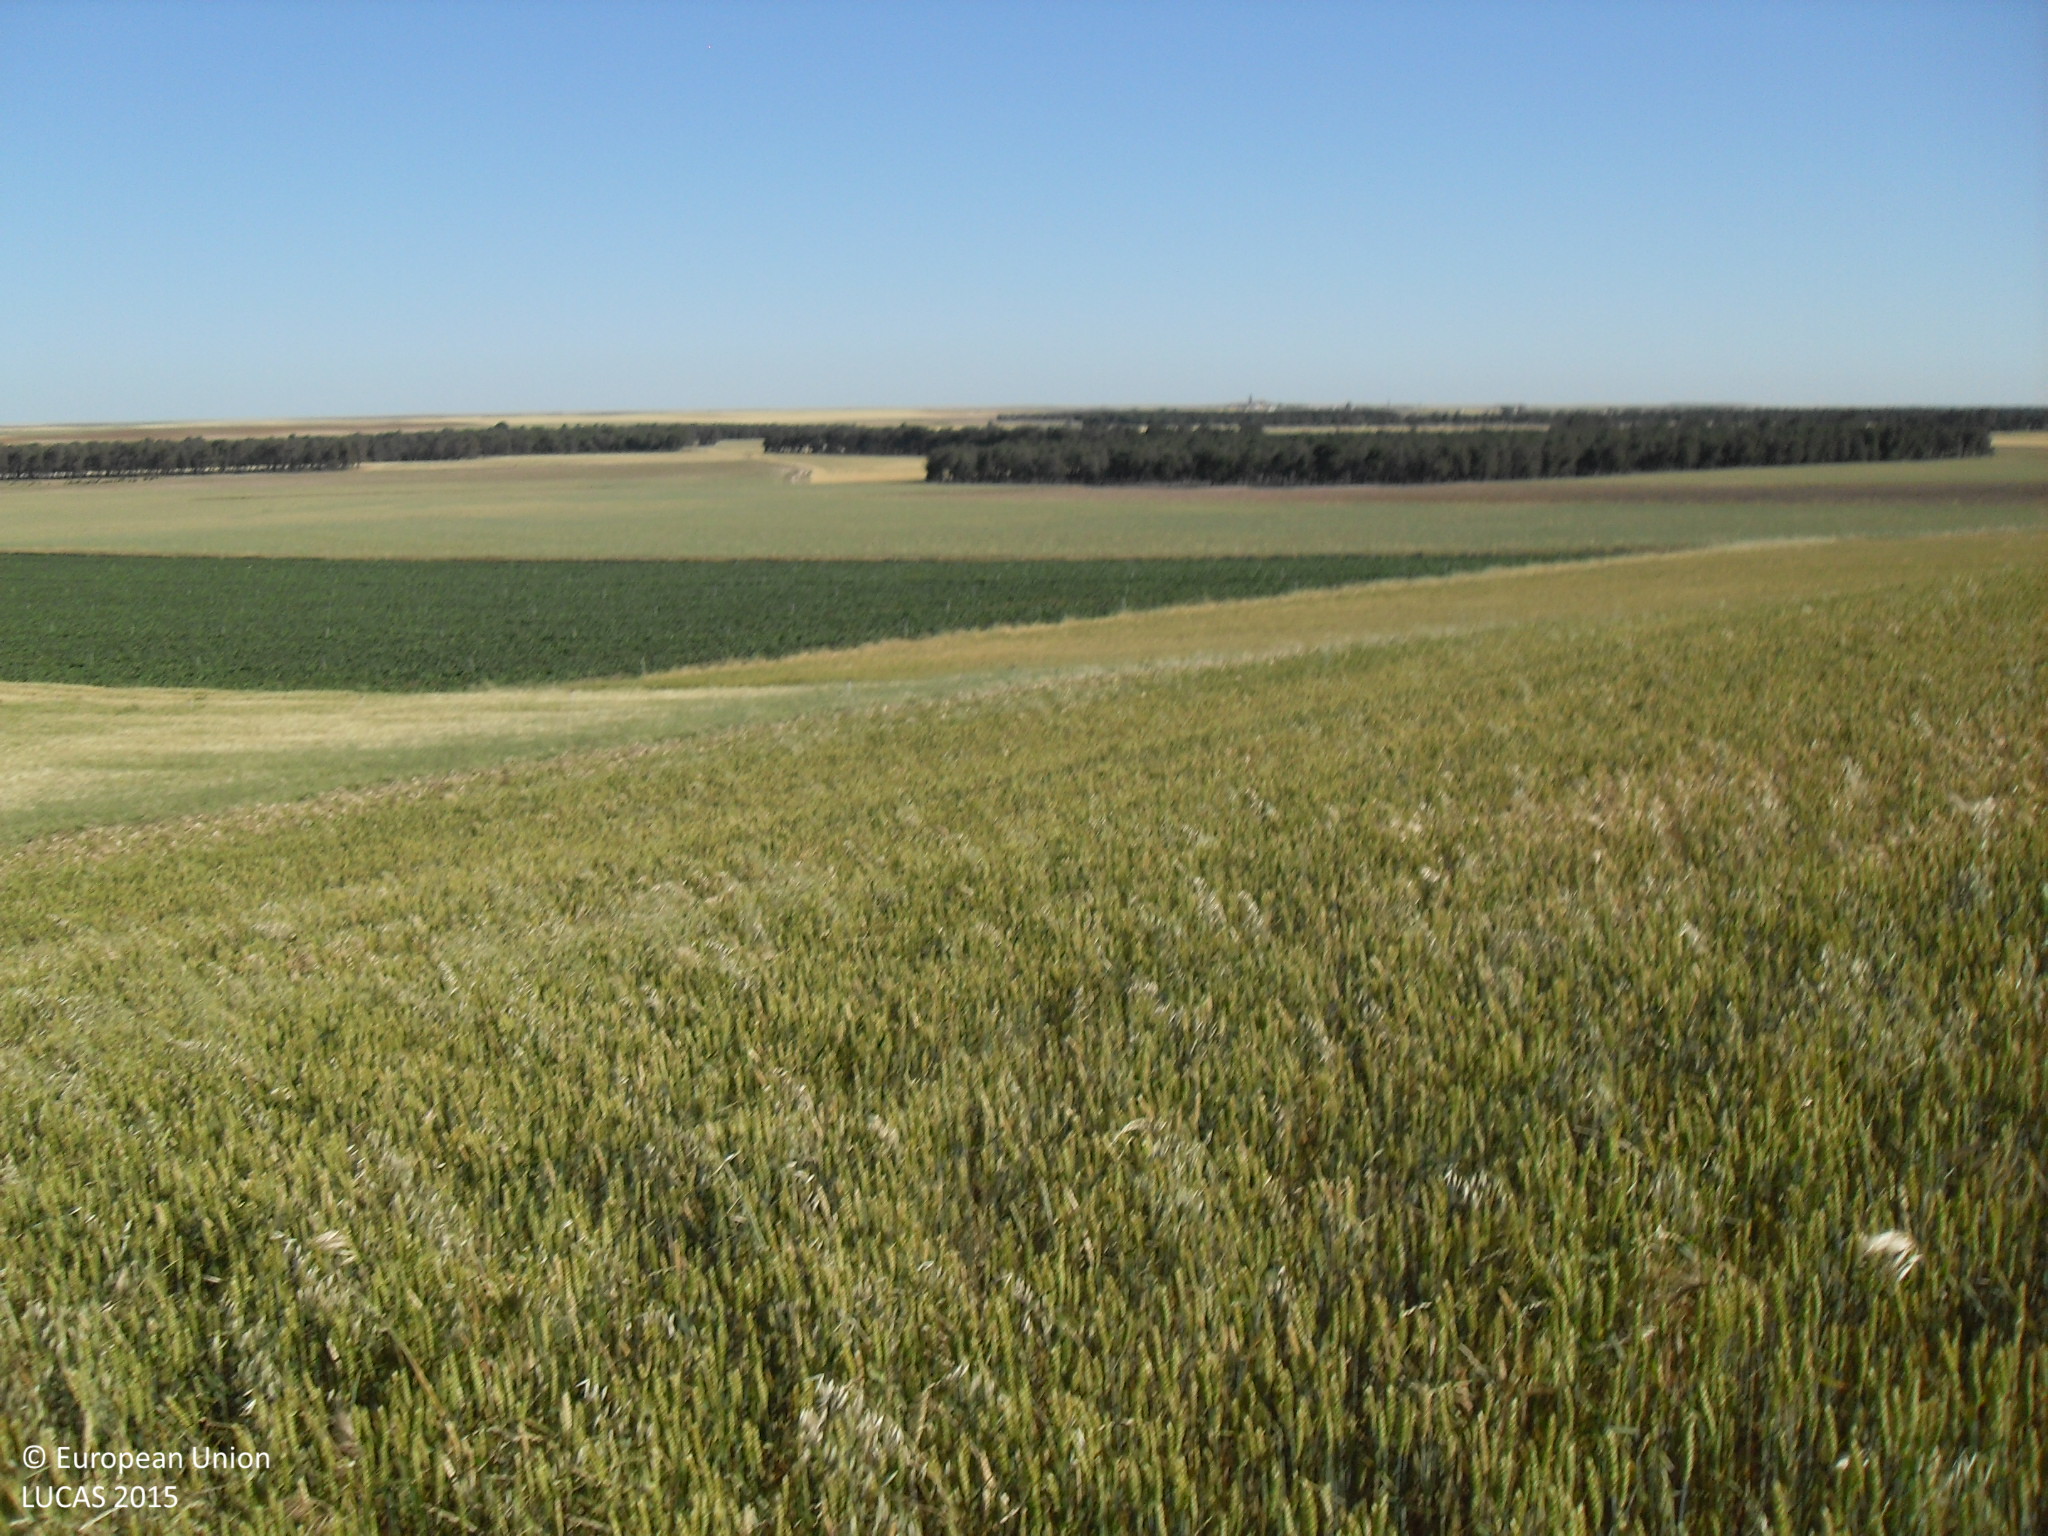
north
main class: Cropland
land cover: Common wheat
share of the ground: > 75 %
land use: Agriculture (excluding fallow land and kitchen gardens)
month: May
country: ES
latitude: 41.1657
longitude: -5.2199
